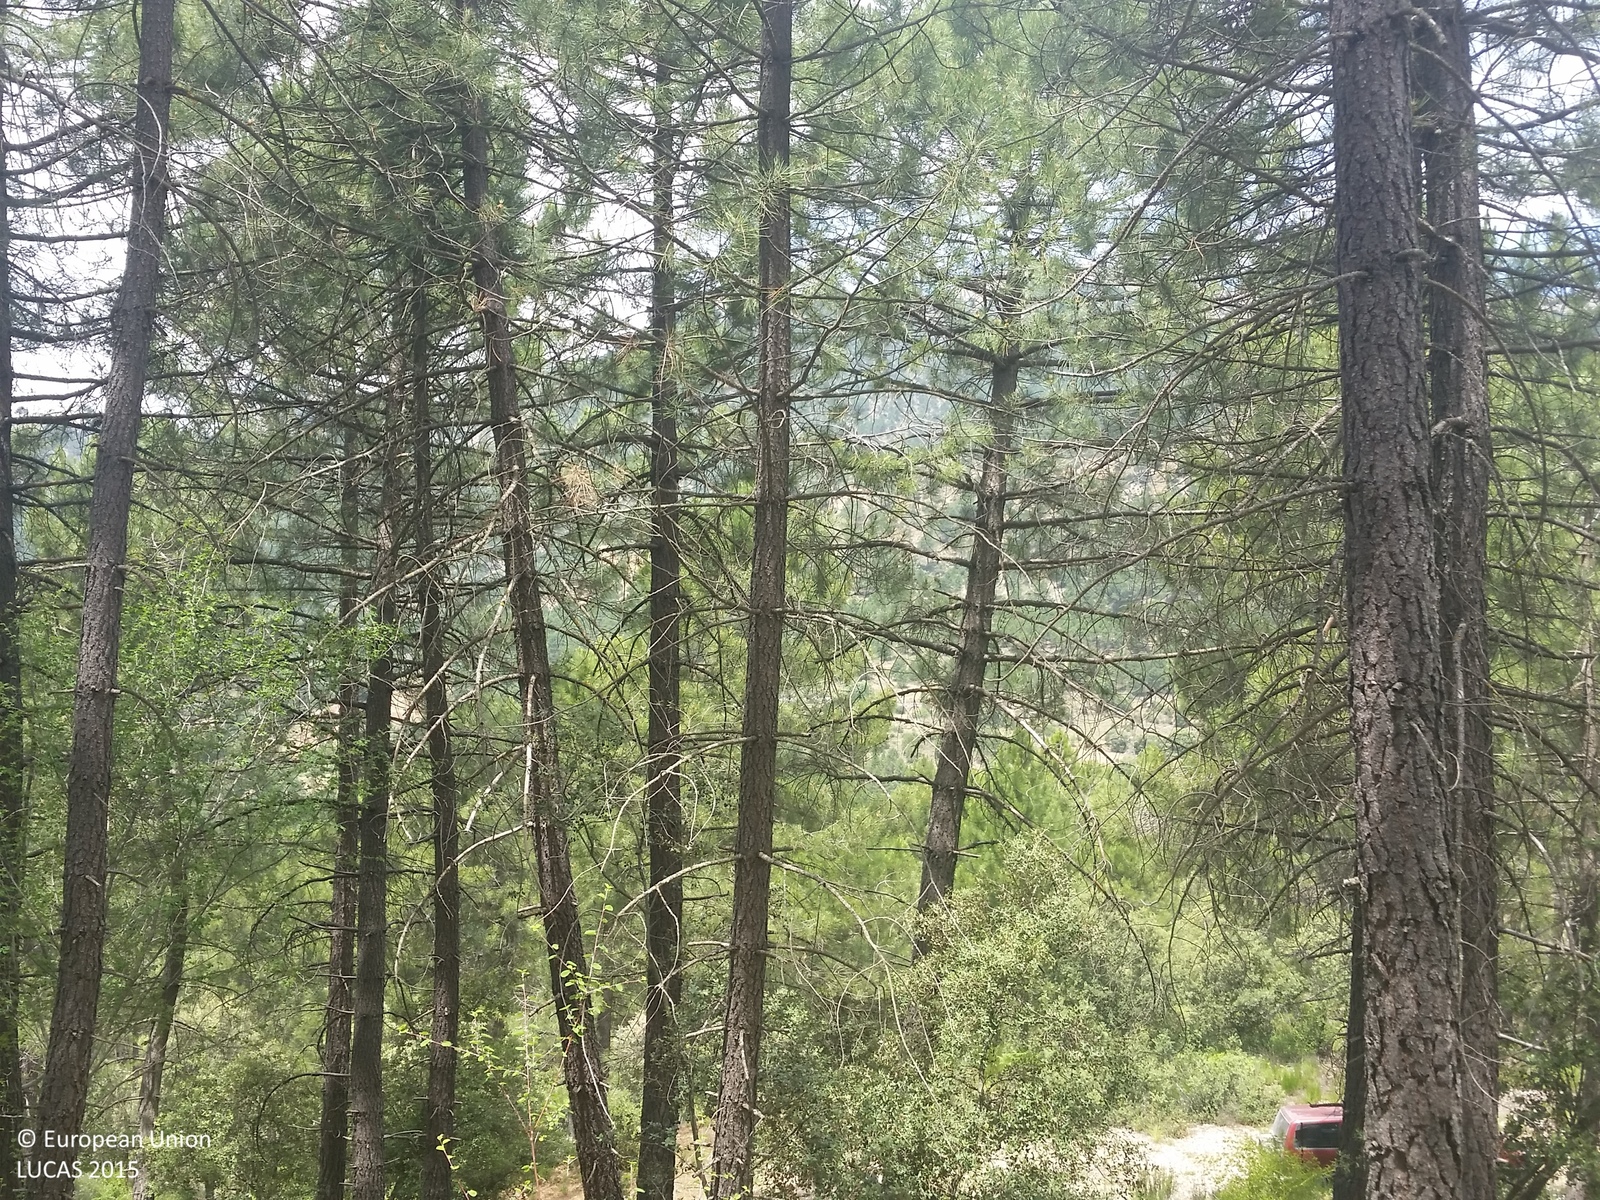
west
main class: Woodland
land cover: Pine dominated coniferous woodland
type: coniferous forest of the mediterranean region
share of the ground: > 75 %
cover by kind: coniferous forest trees 100 %
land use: Forestry
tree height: > 5 m
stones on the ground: 10 - 25 %
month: June
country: ES
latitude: 38.5204
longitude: -2.4434
